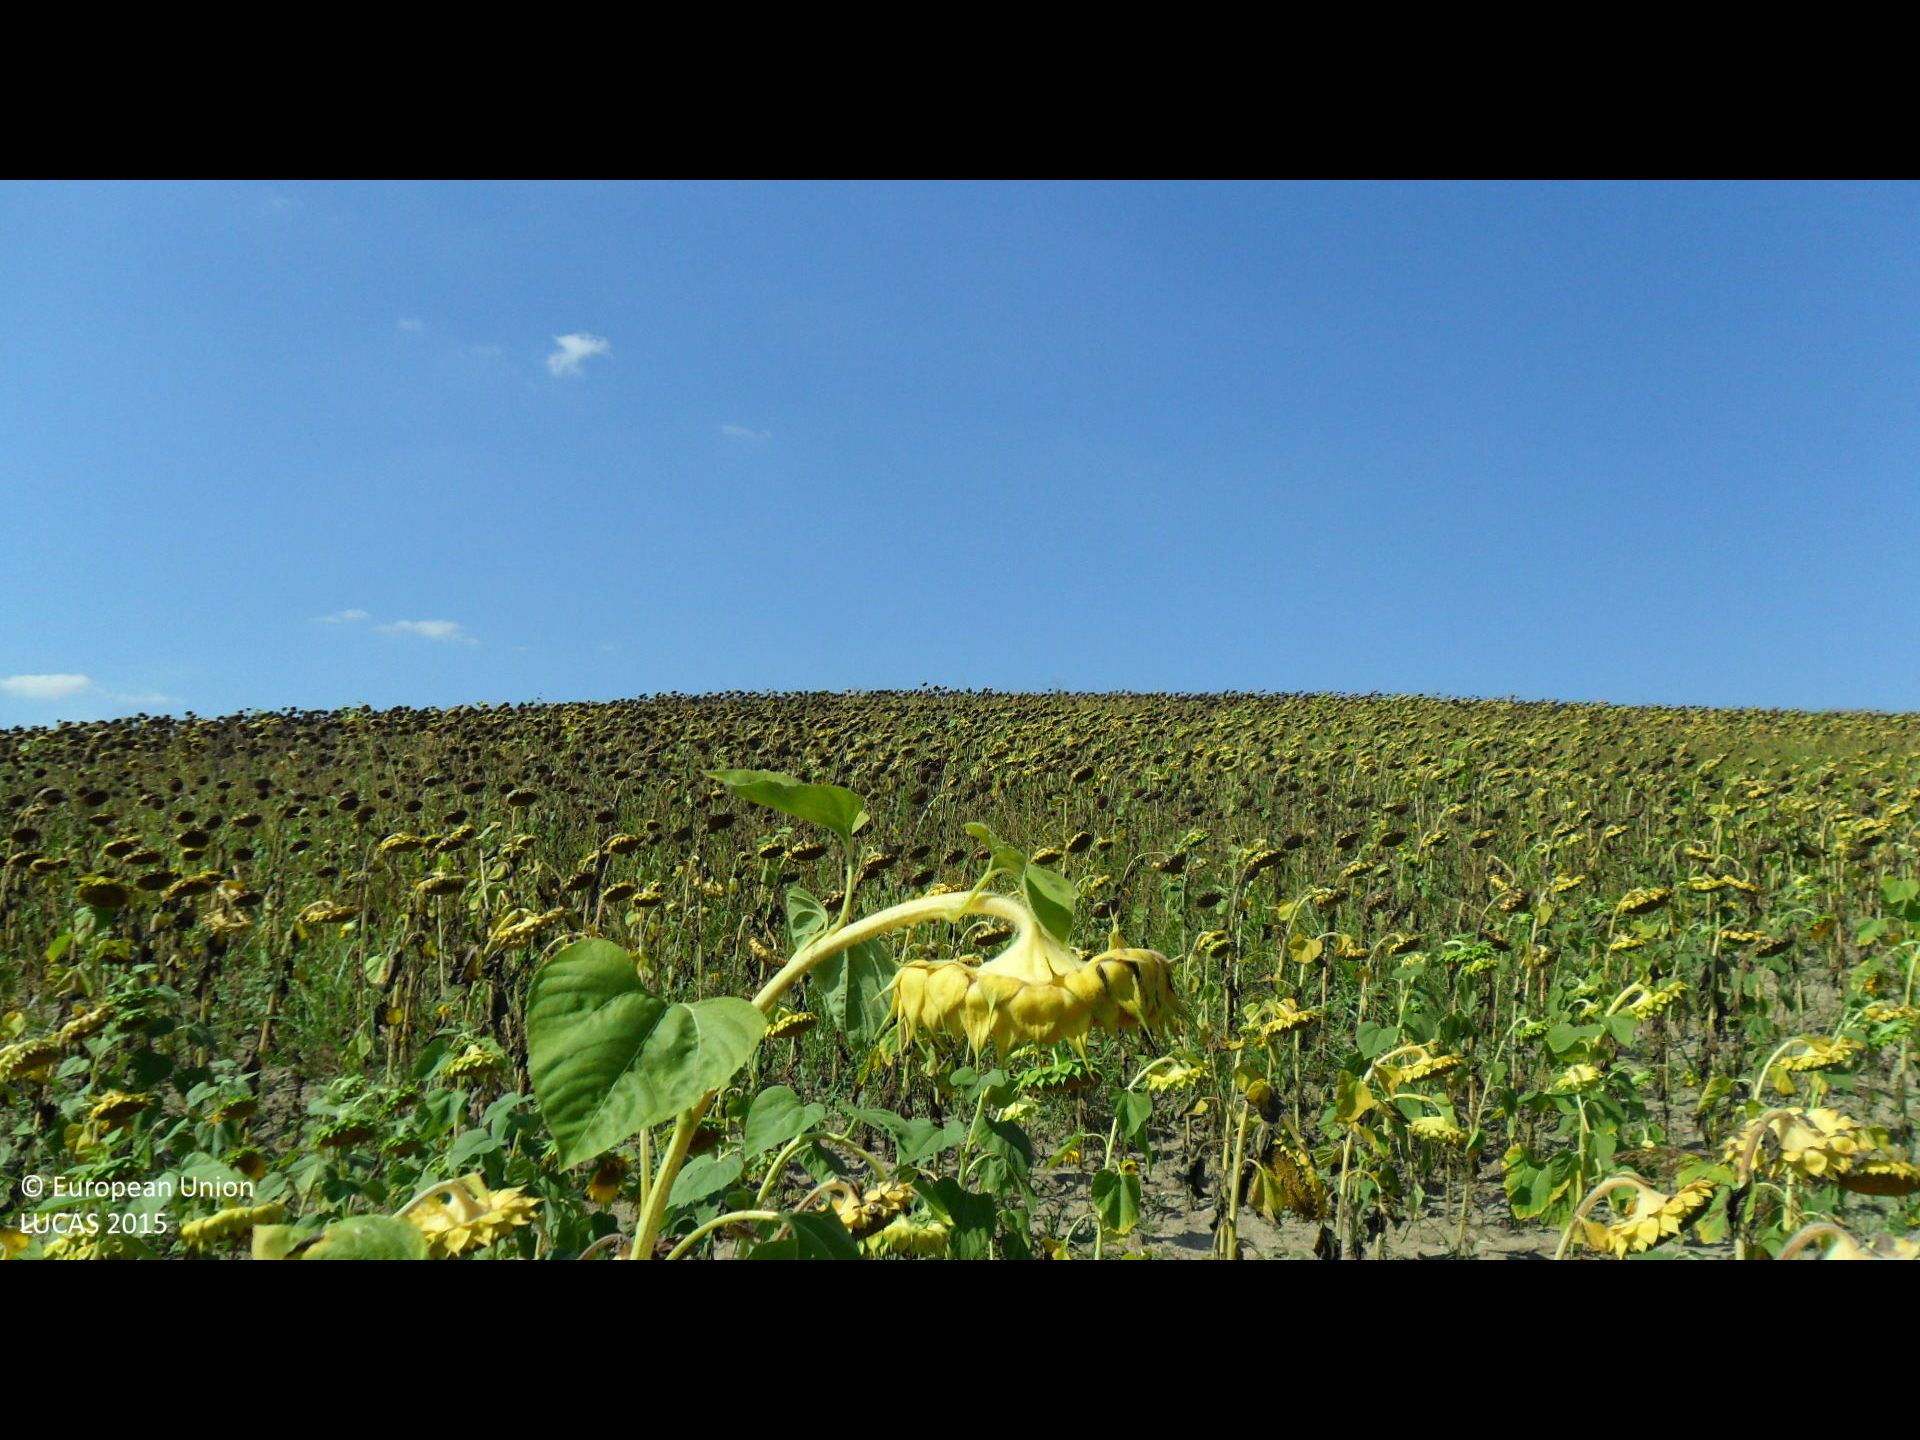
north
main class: Cropland
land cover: Sunflower
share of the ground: > 75 %
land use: Agriculture (excluding fallow land and kitchen gardens)
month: August
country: BG
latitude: 43.4650
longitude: 26.3545
